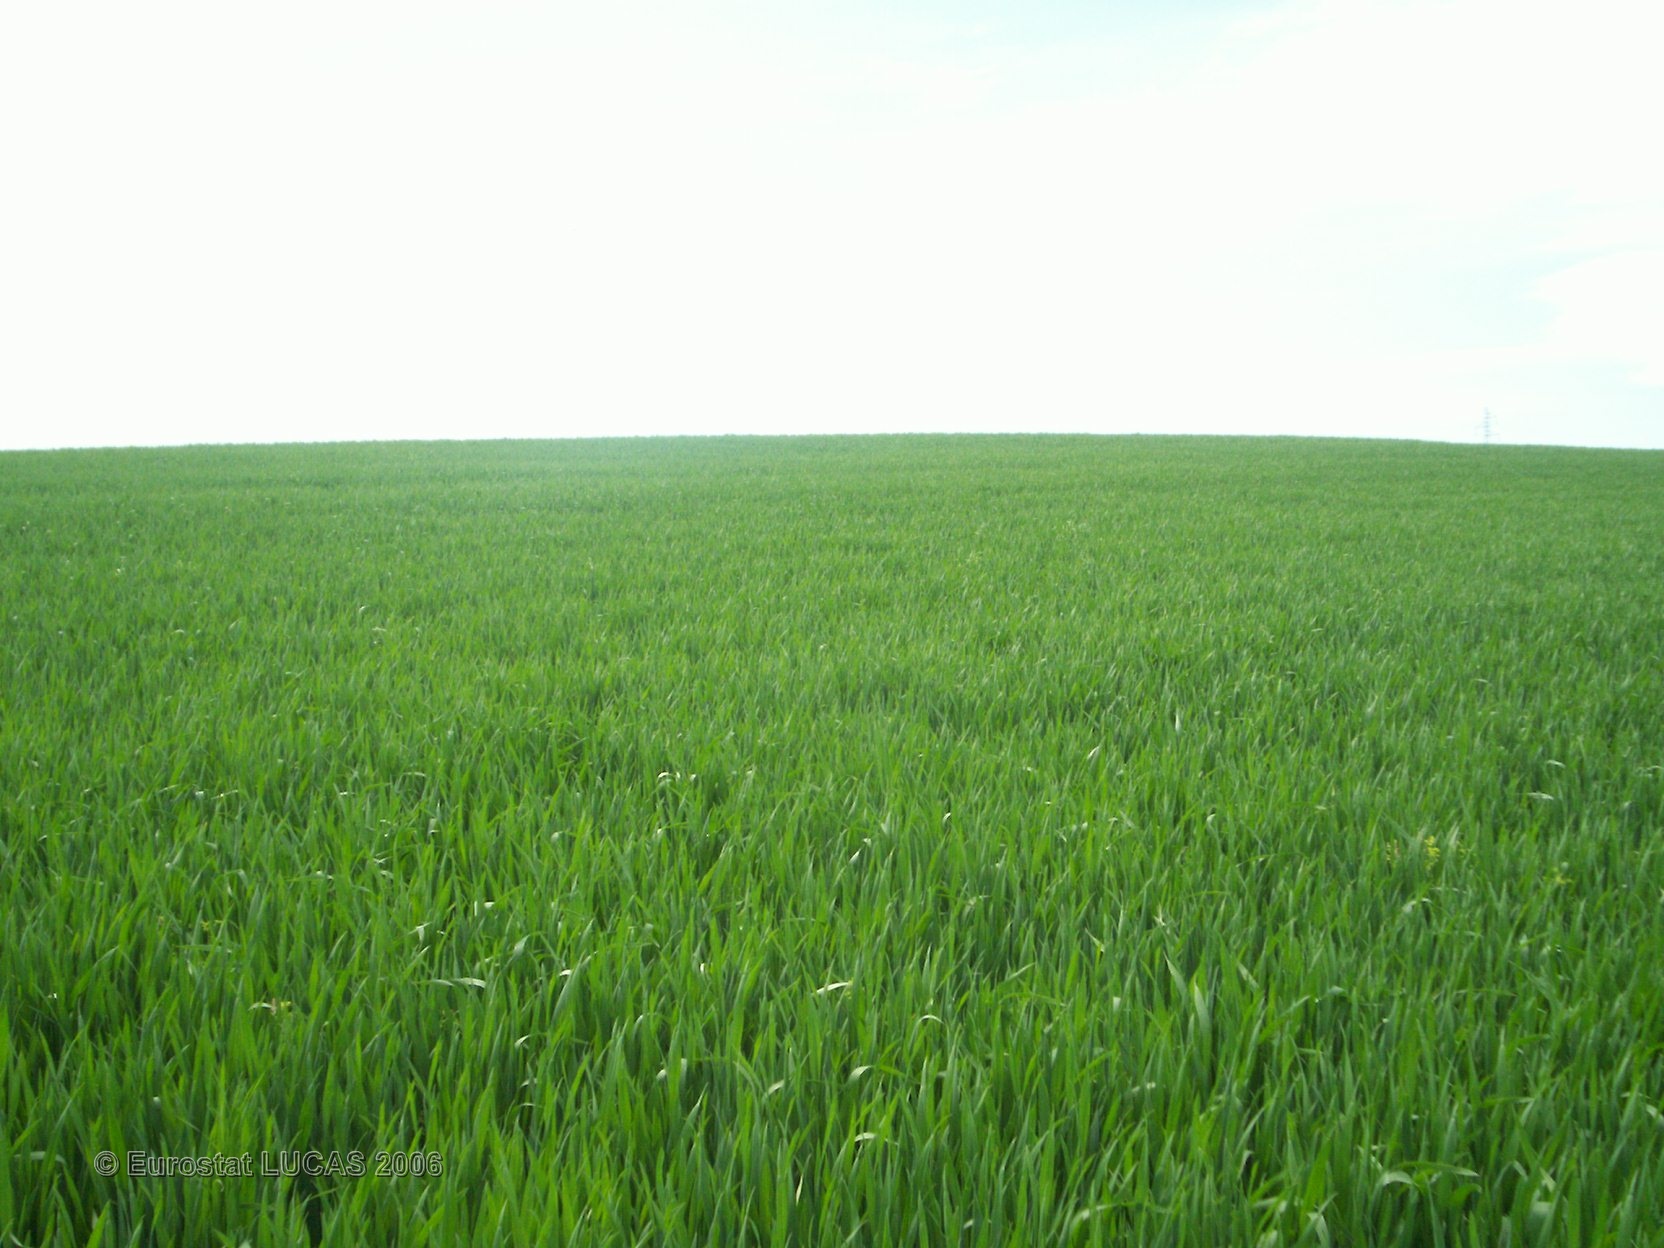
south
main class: Cropland
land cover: Common wheat
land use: Agriculture (excluding fallow land and kitchen gardens)
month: May
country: FR
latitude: 46.2441
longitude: 3.2156
